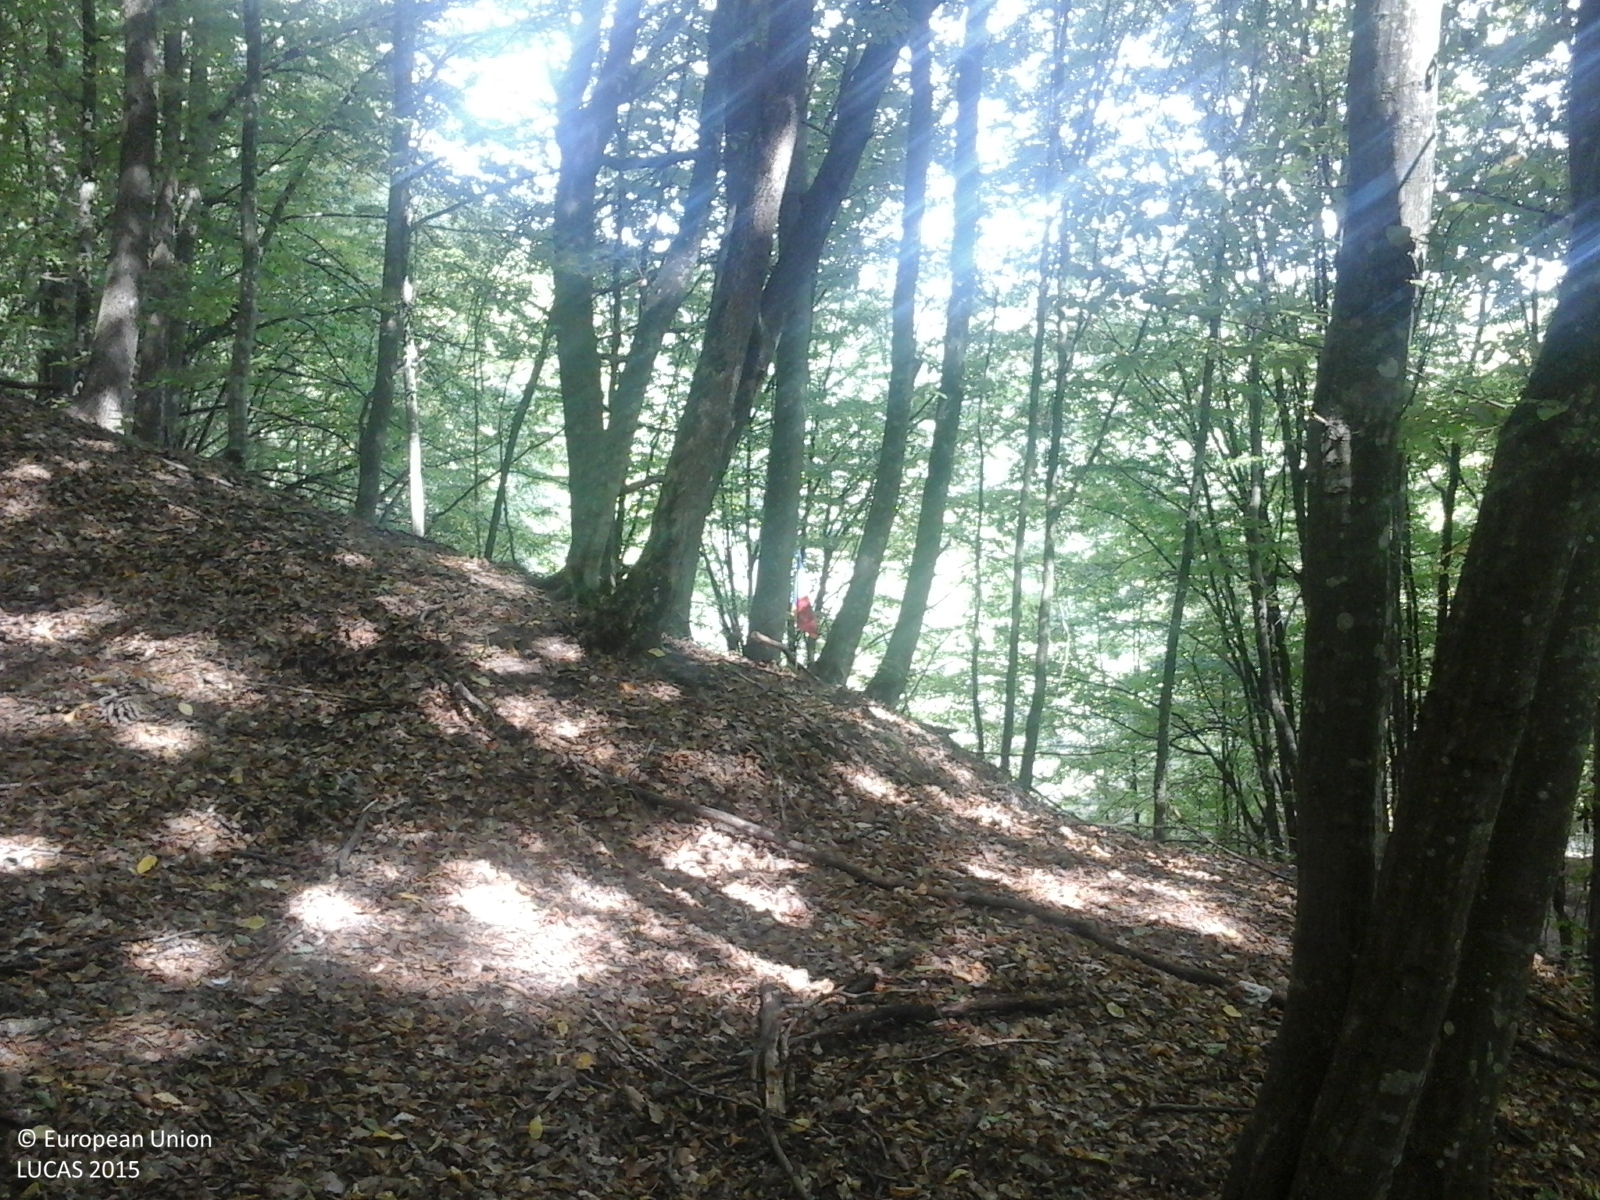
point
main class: Woodland
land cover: Broadleaved woodland
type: beech forest
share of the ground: > 75 %
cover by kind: broadleaved forest trees 100 %
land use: Forestry
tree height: > 5 m
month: September
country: RO
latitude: 47.2924
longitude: 23.6827
